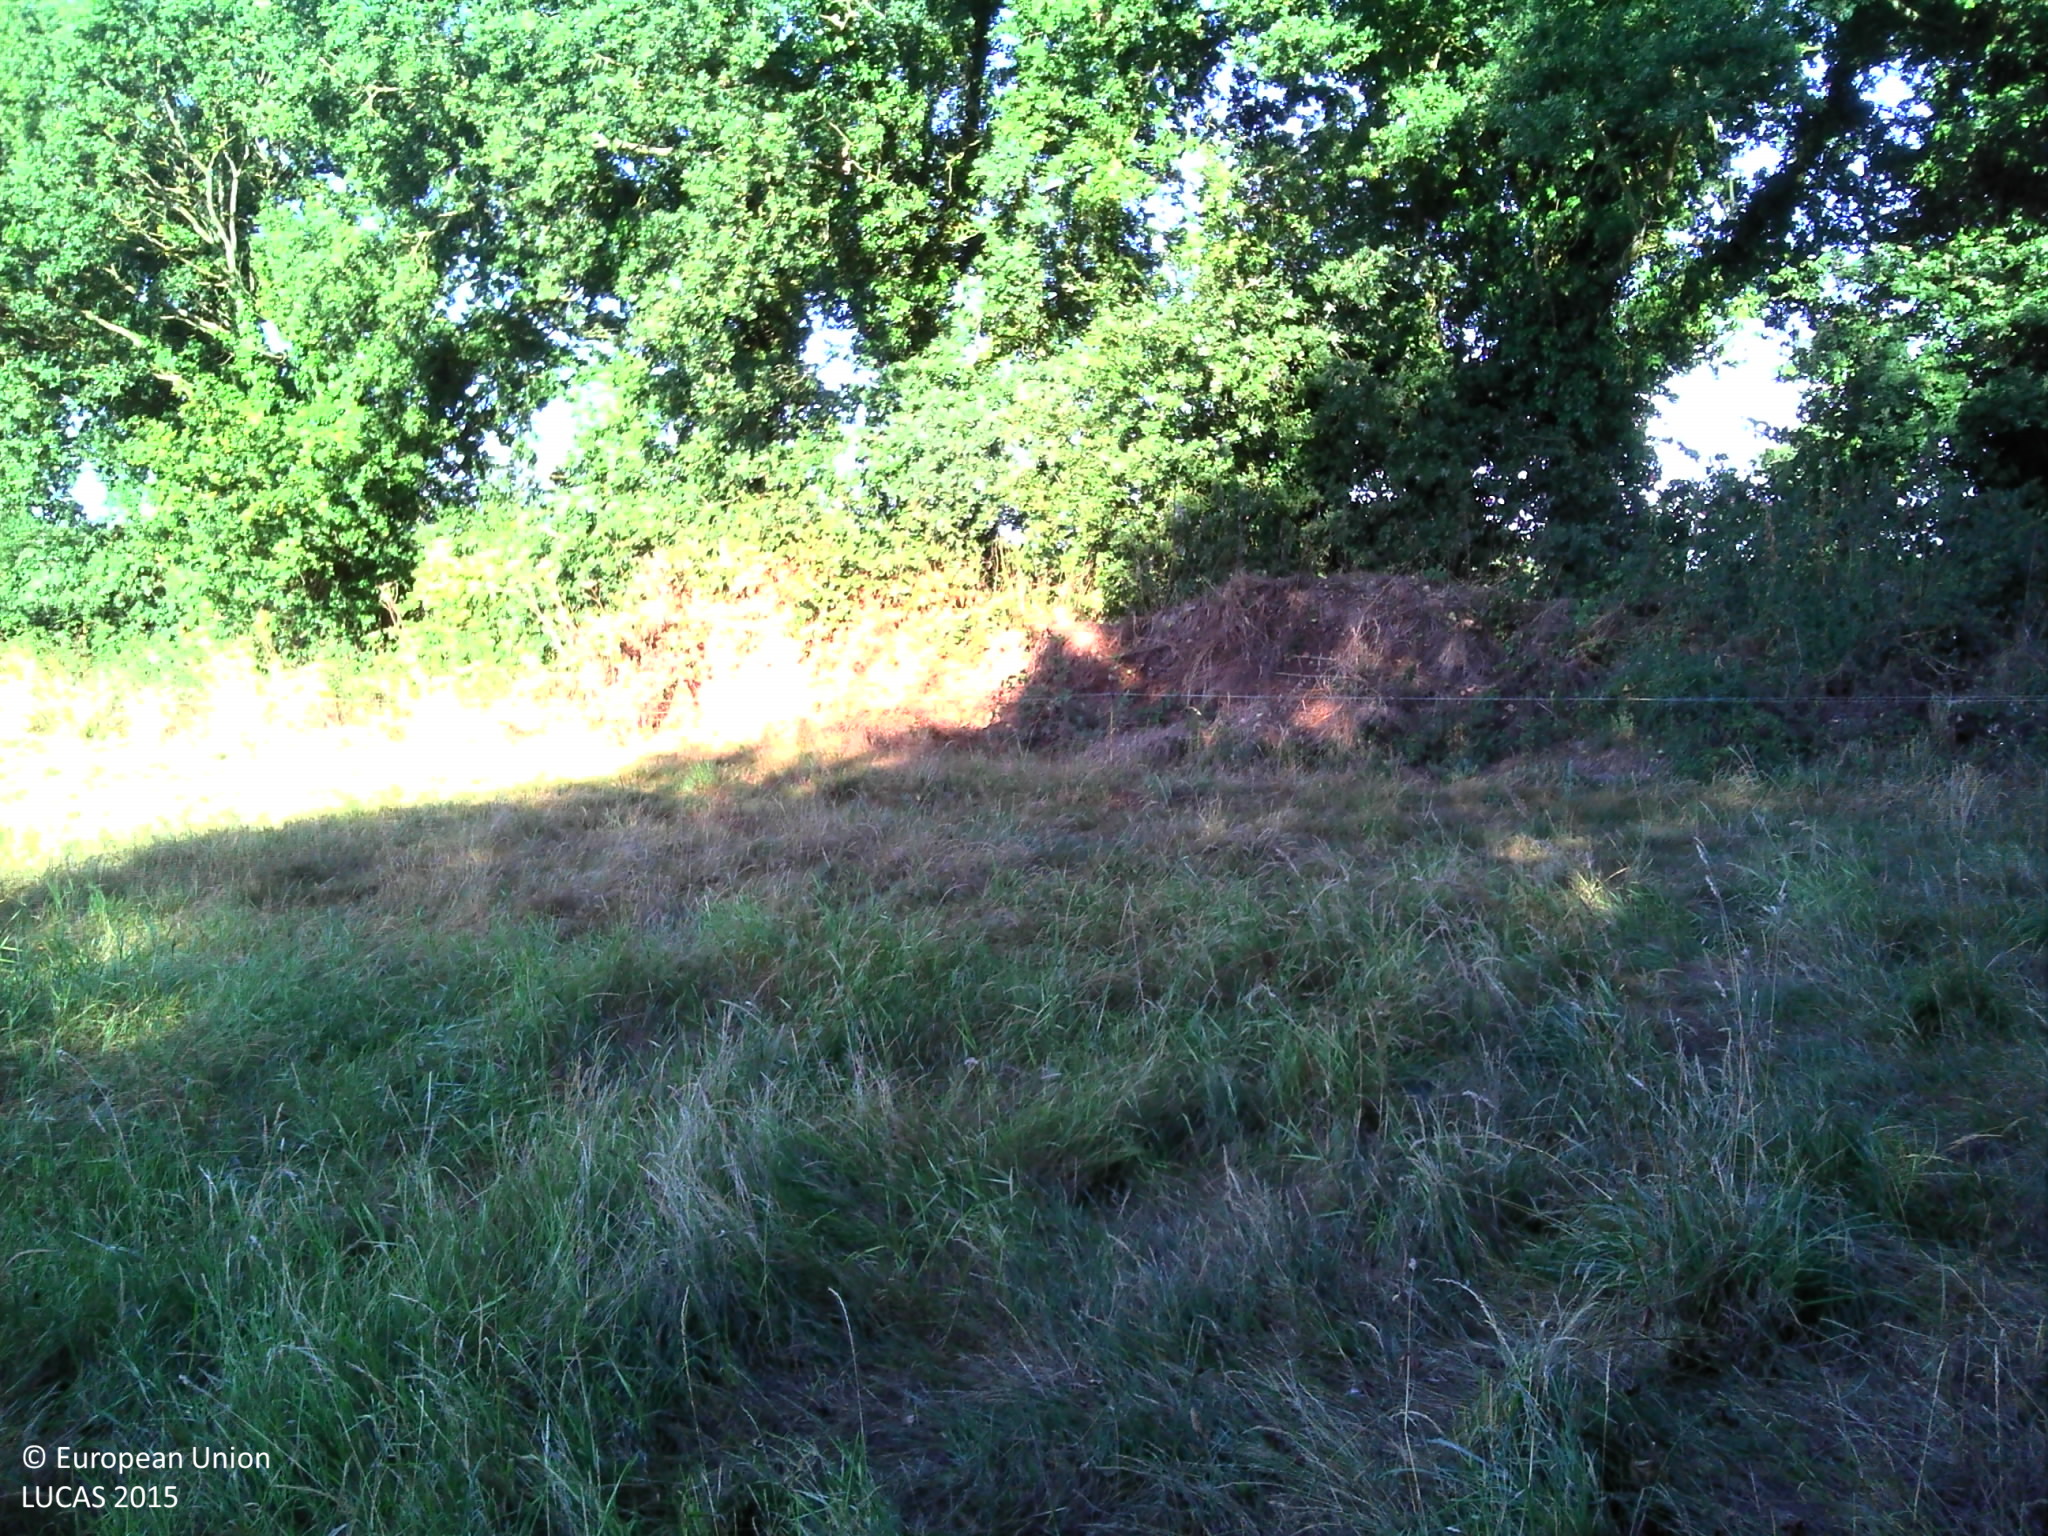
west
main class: Grassland
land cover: Grassland without tree/shrub cover
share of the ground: > 75 %
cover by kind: herbaceous plants 100 %
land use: Agriculture (excluding fallow land and kitchen gardens)
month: August
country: FR
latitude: 47.4309
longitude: -1.5644
